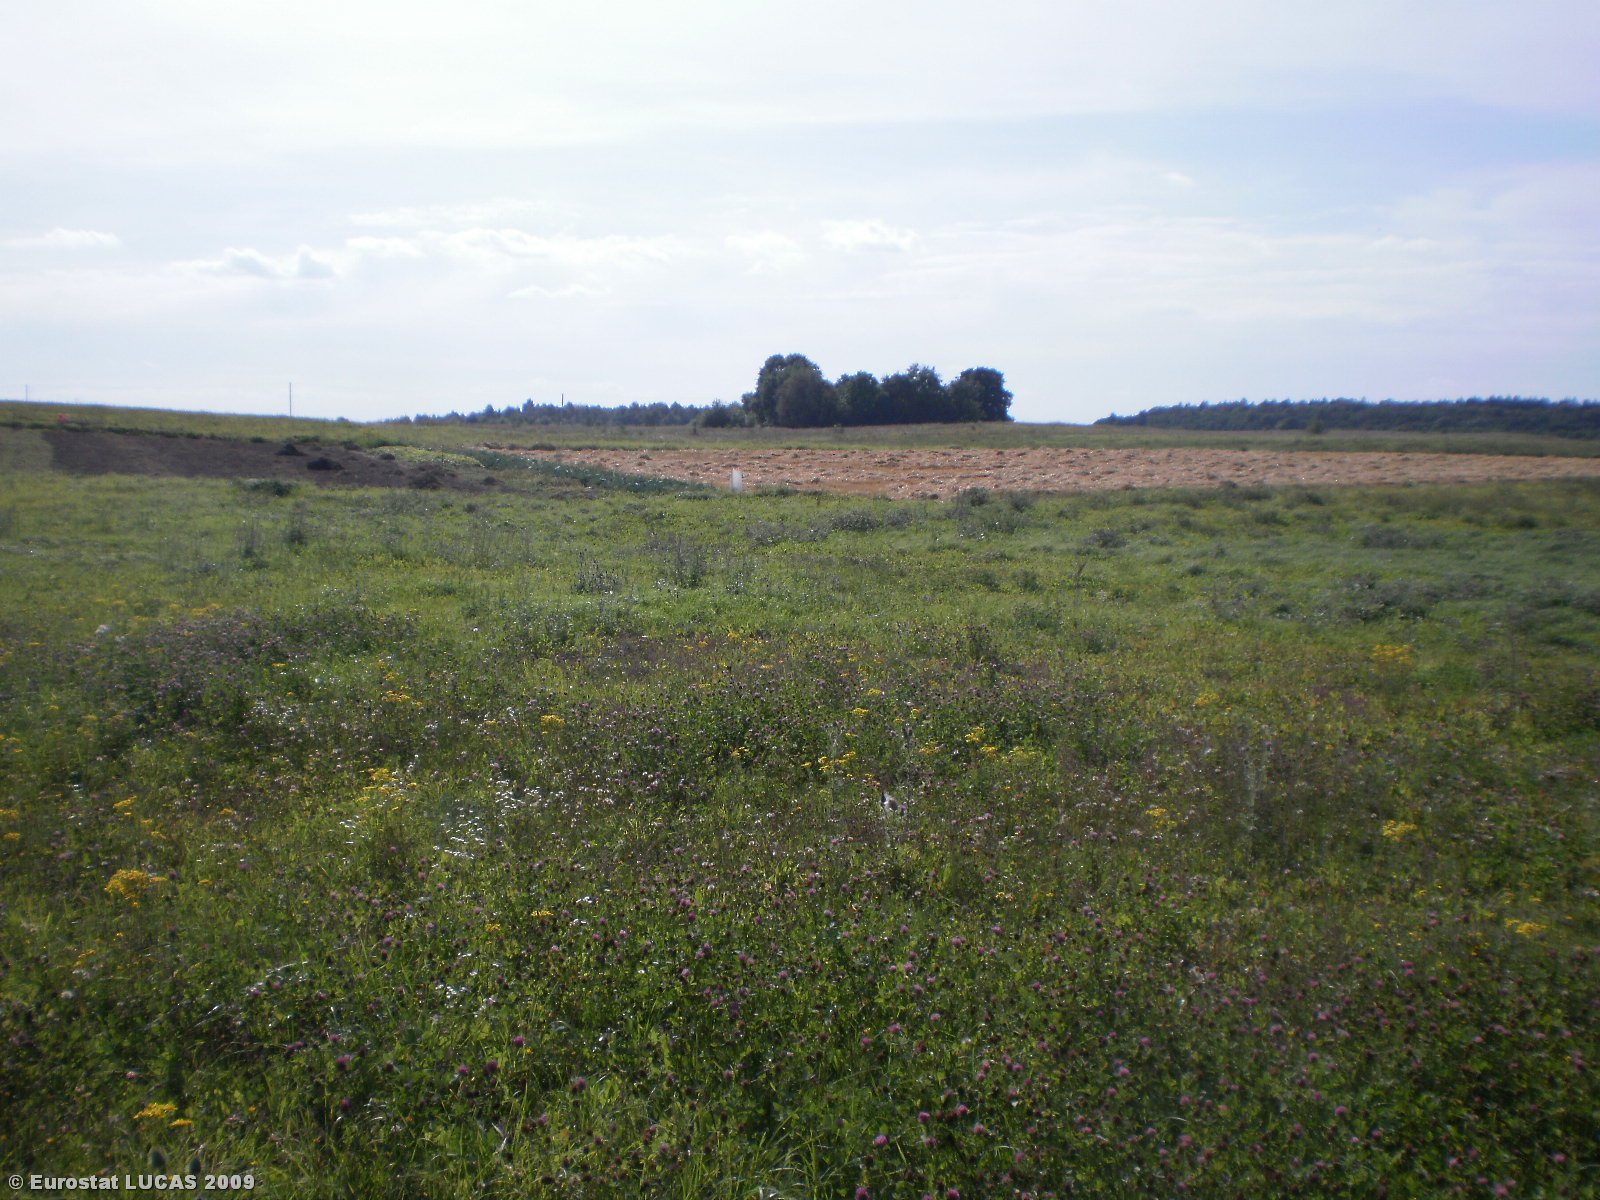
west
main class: Grassland
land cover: Grassland without tree/shrub cover
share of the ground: > 75 %
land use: Agriculture (excluding fallow land and kitchen gardens)
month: August
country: LT
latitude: 54.9288
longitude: 24.5697
